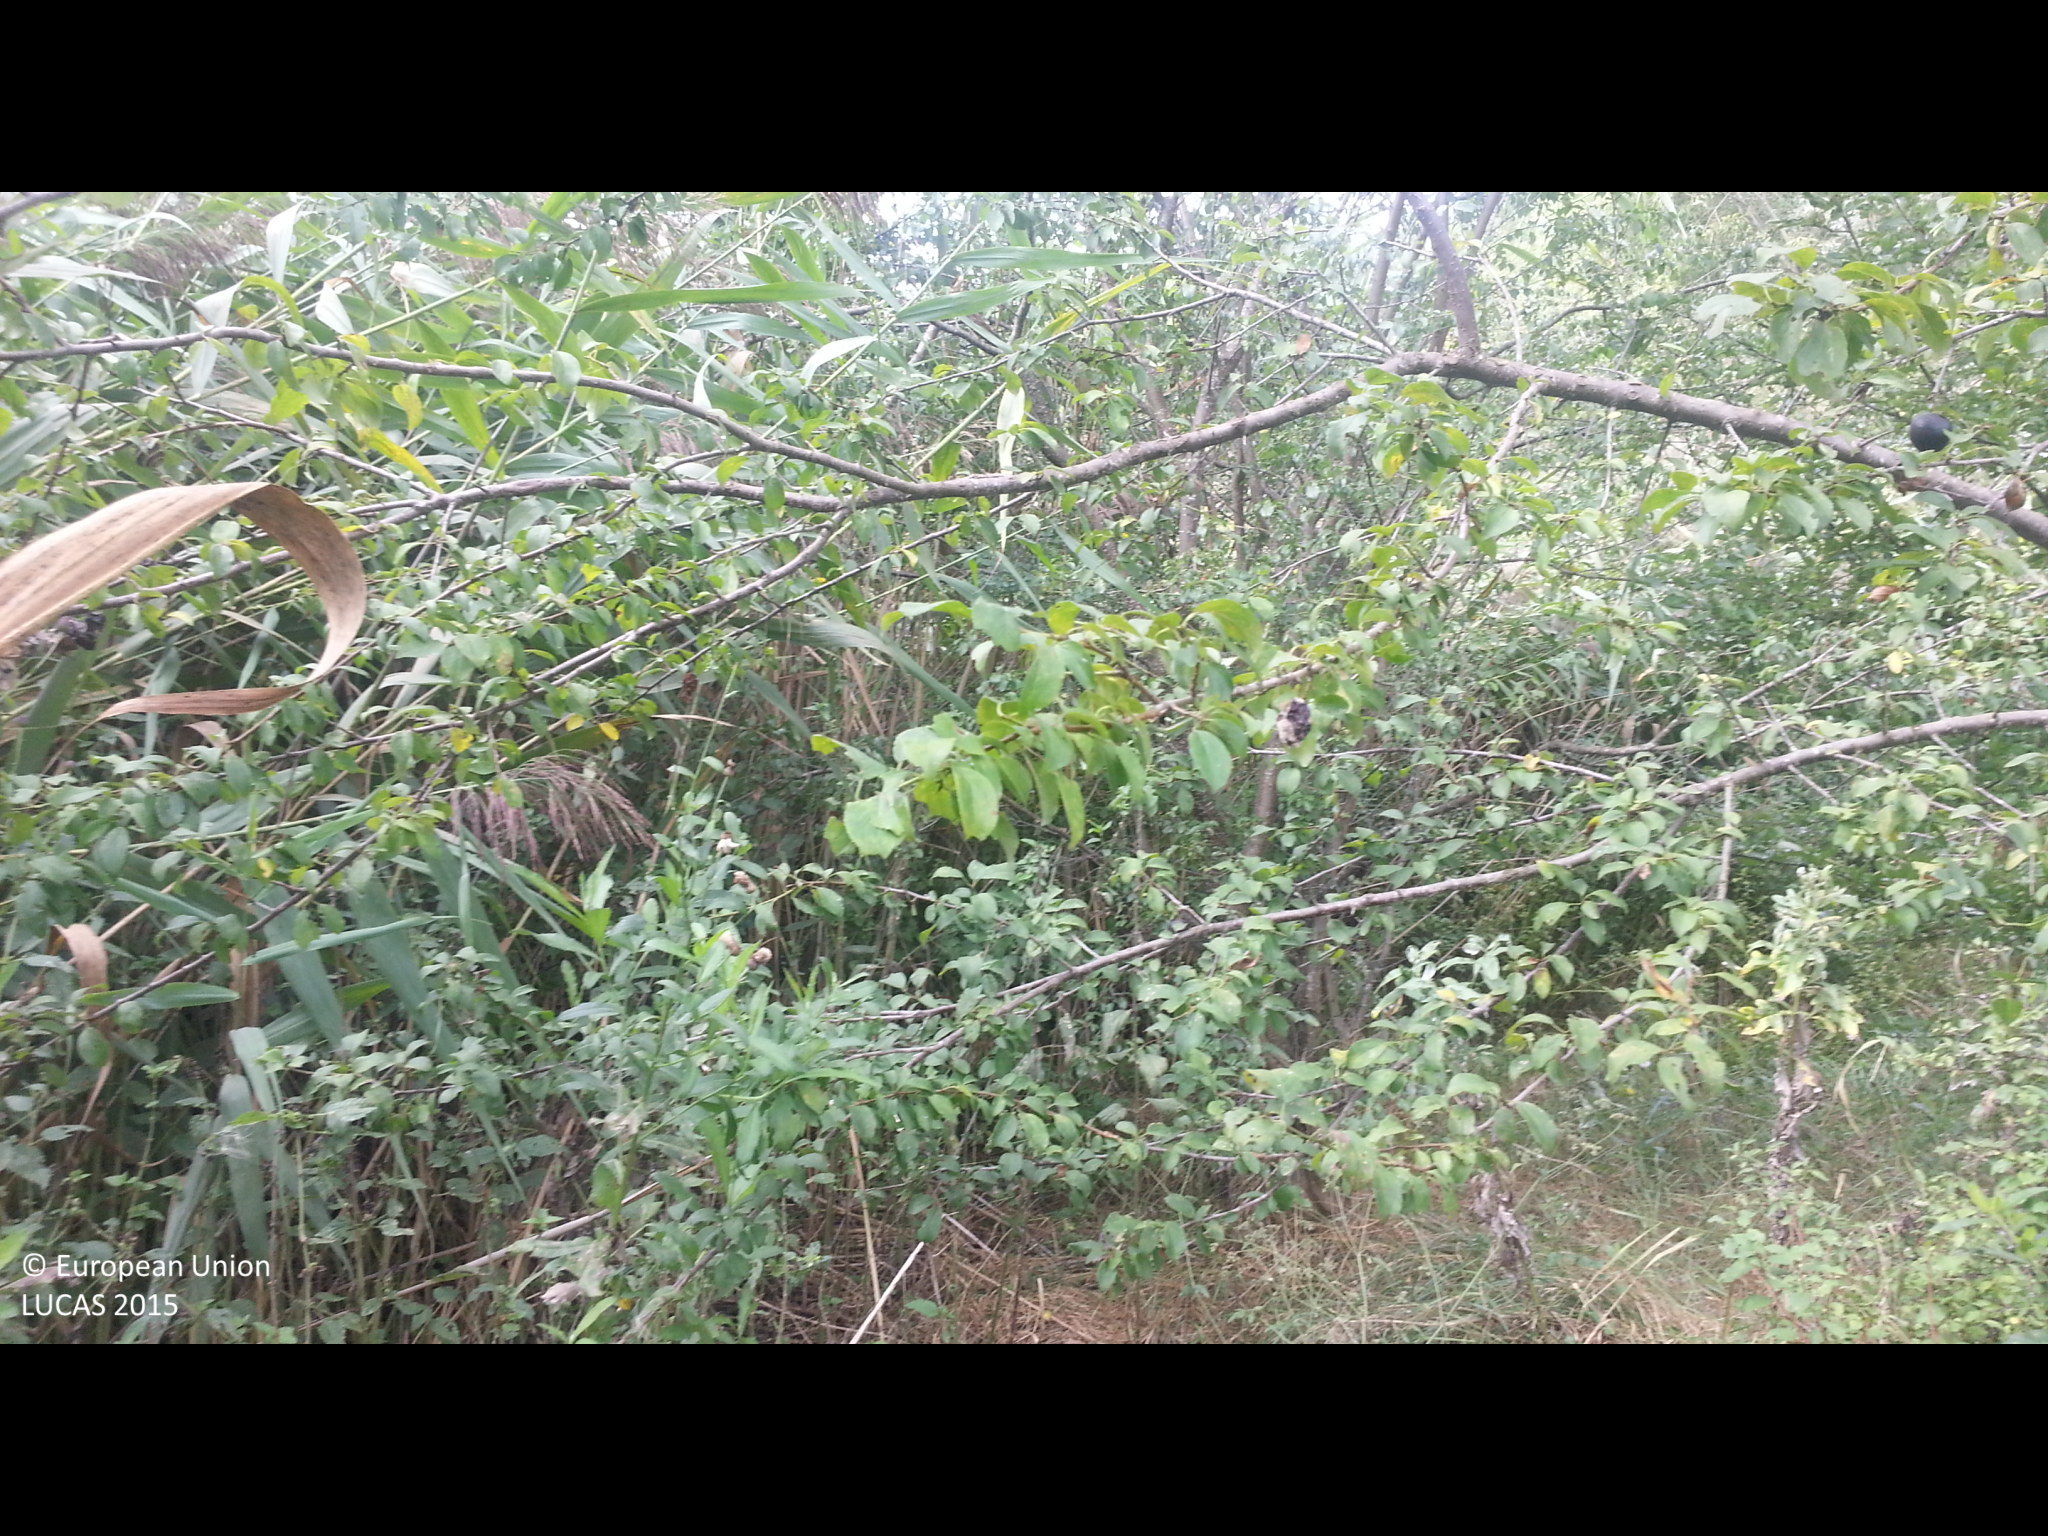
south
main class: Grassland
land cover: Grassland with sparse tree/shrub cover
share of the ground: > 75 %
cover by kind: herbaceous plants 85 %, shrubs 10 %, broadleaved forest trees 5 %
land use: Semi-natural and natural areas not in use
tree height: < 5 m
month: August
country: BG
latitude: 42.4020
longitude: 22.8180
